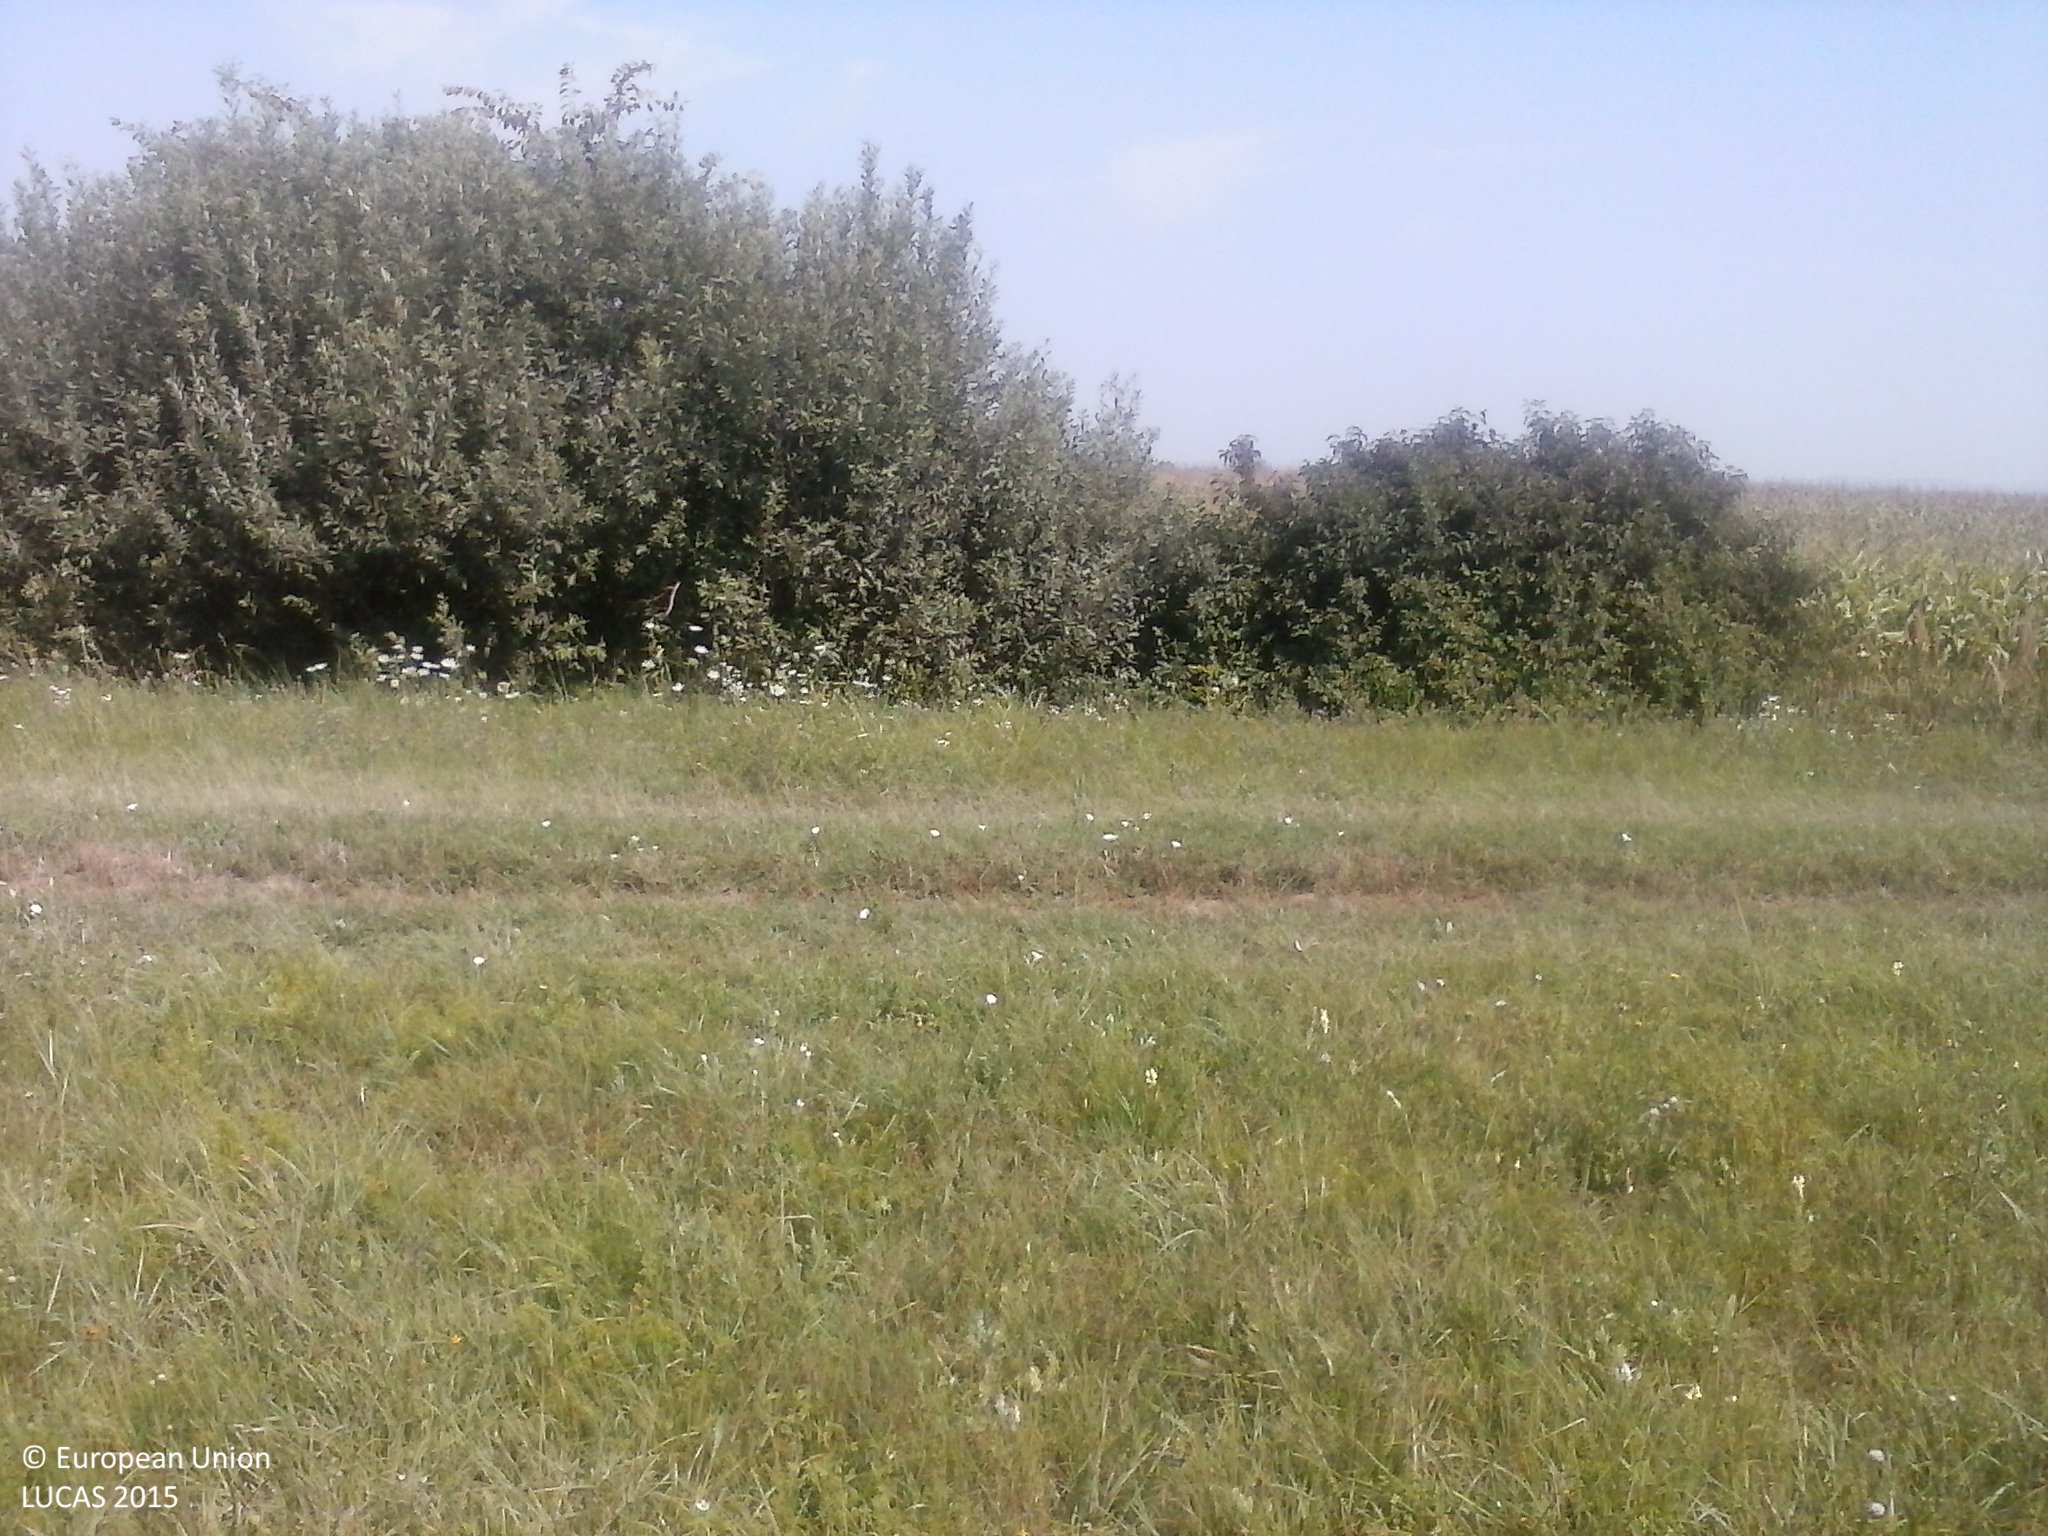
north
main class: Cropland
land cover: Maize
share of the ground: > 75 %
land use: Agriculture (excluding fallow land and kitchen gardens)
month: August
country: HU
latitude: 45.9313
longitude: 17.9105
